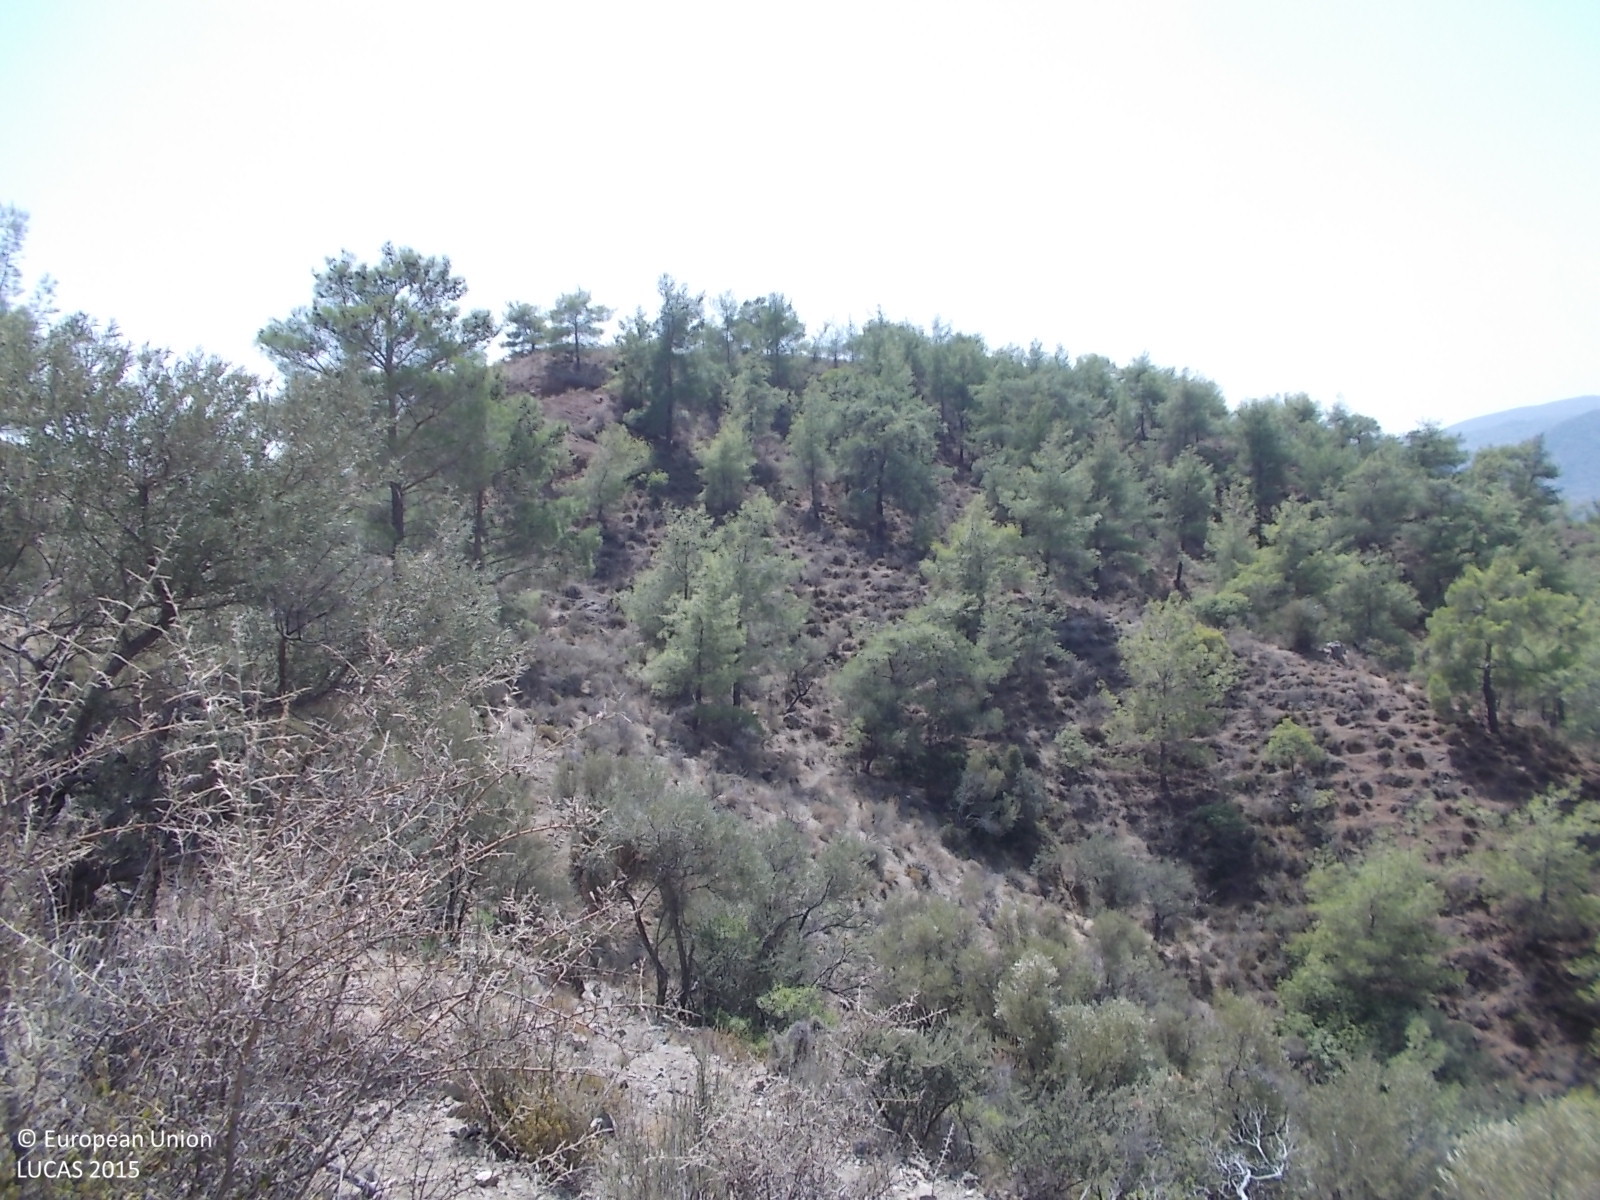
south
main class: Woodland
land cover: Pine dominated mixed woodland
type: coniferous forest of the mediterranean region
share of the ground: 50 - 75 %
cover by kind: coniferous forest trees 40 %, unconsolidated bare surface 35 %, broadleaved forest trees 15 %, shrubs 10 %
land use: Semi-natural and natural areas not in use
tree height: > 5 m
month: April
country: CY
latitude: 34.8540
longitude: 33.1316
